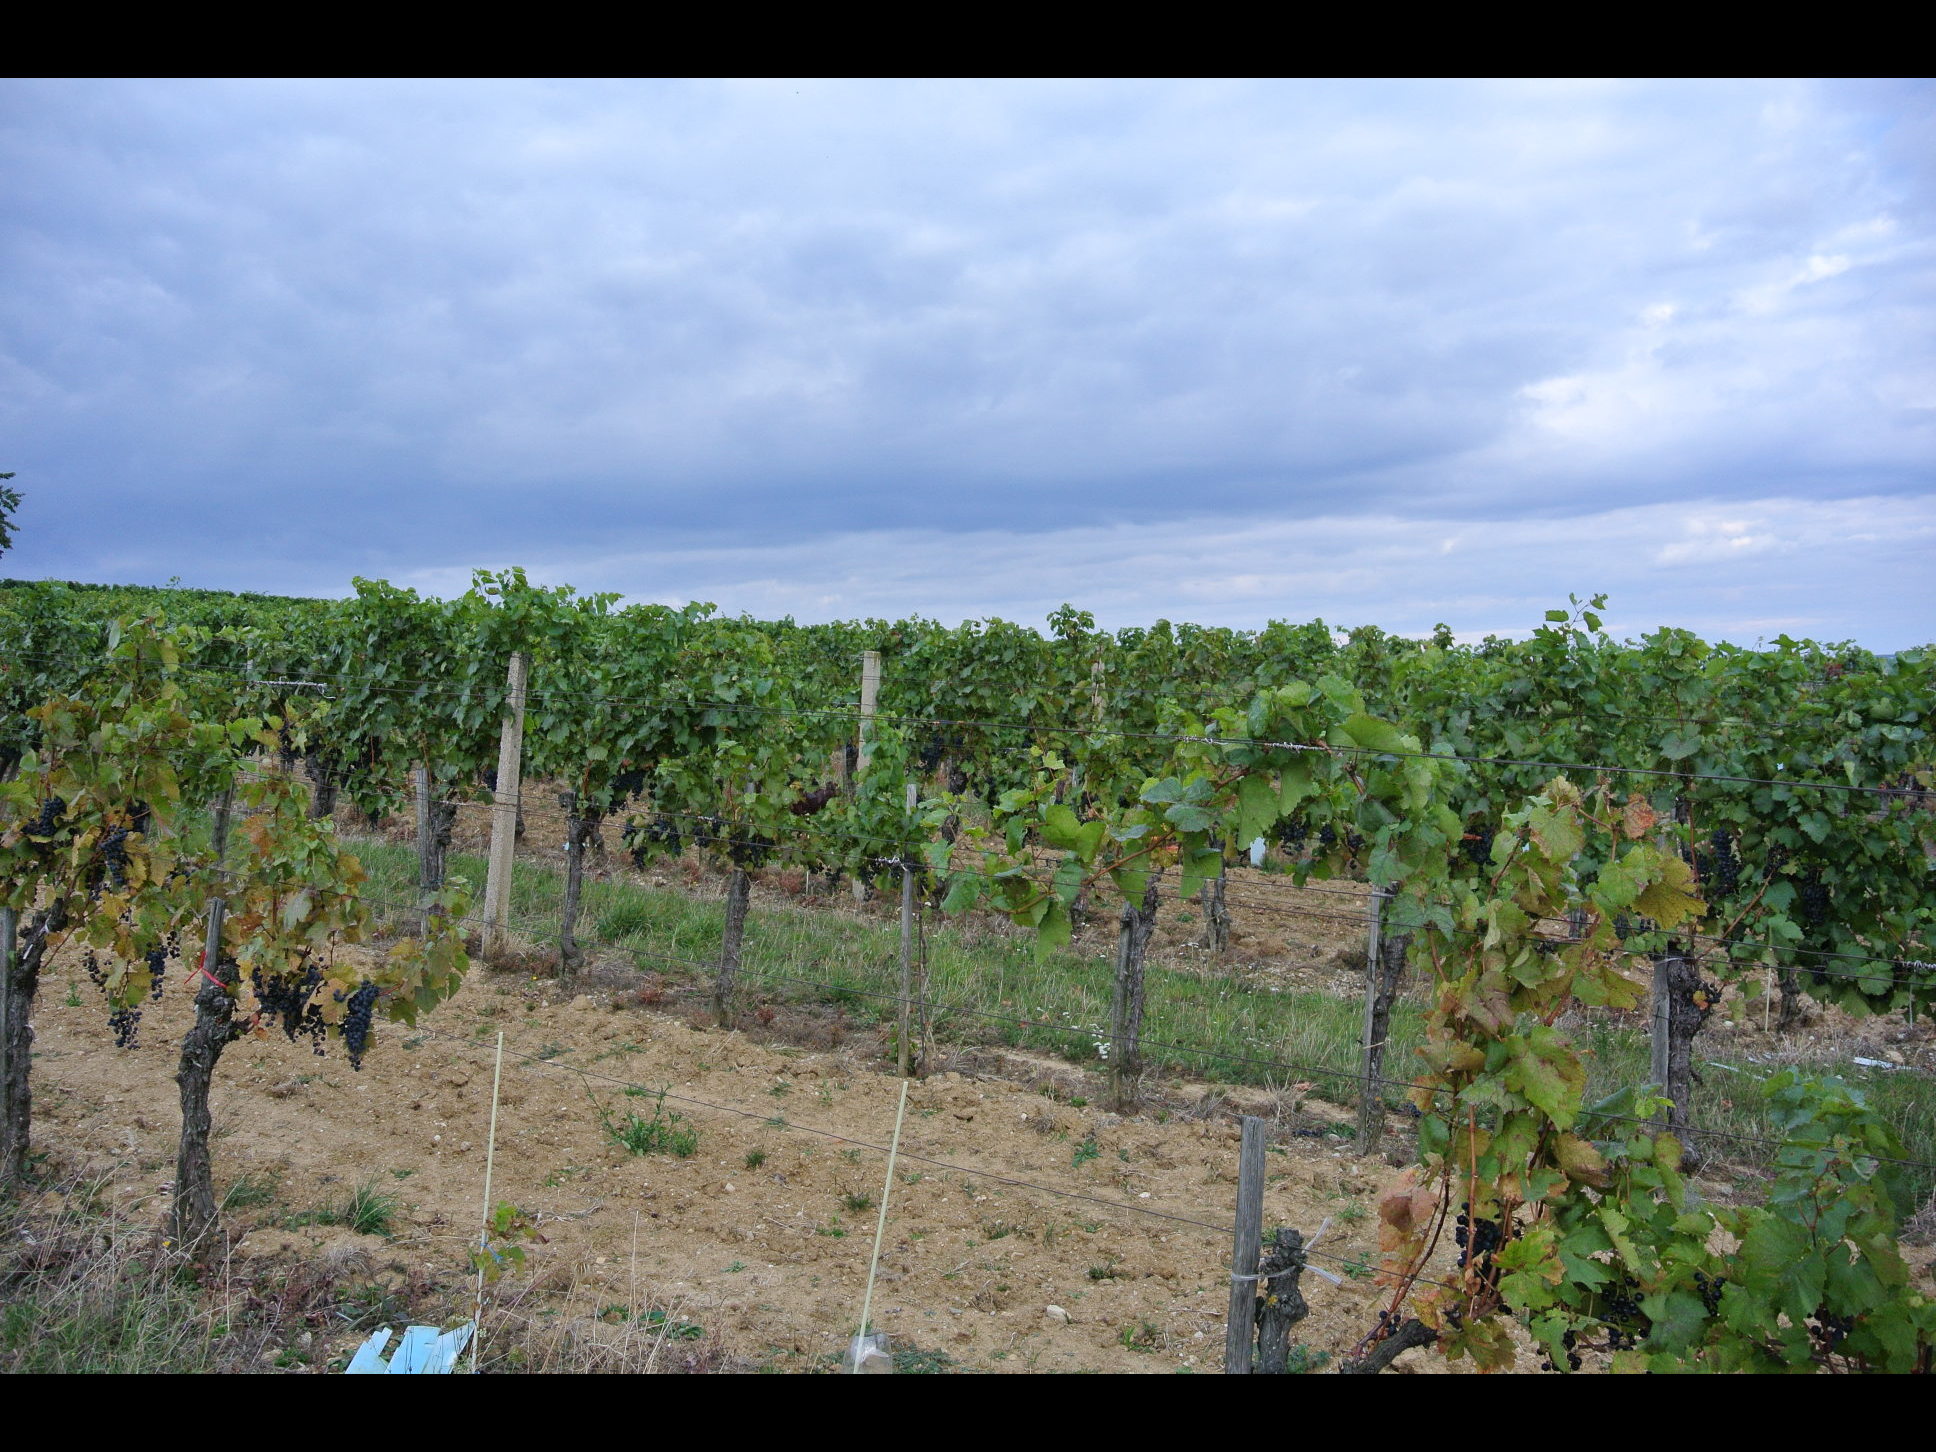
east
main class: Grassland
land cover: Grassland without tree/shrub cover
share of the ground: > 75 %
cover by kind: herbaceous plants 100 %
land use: Agriculture (excluding fallow land and kitchen gardens)
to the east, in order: Grassland without tree/shrub cover; Vineyards; Other fruit trees and berries; Vineyards; Shrubland with sparse tree cover; Vineyards
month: September
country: AT
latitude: 47.6143
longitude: 16.5365
